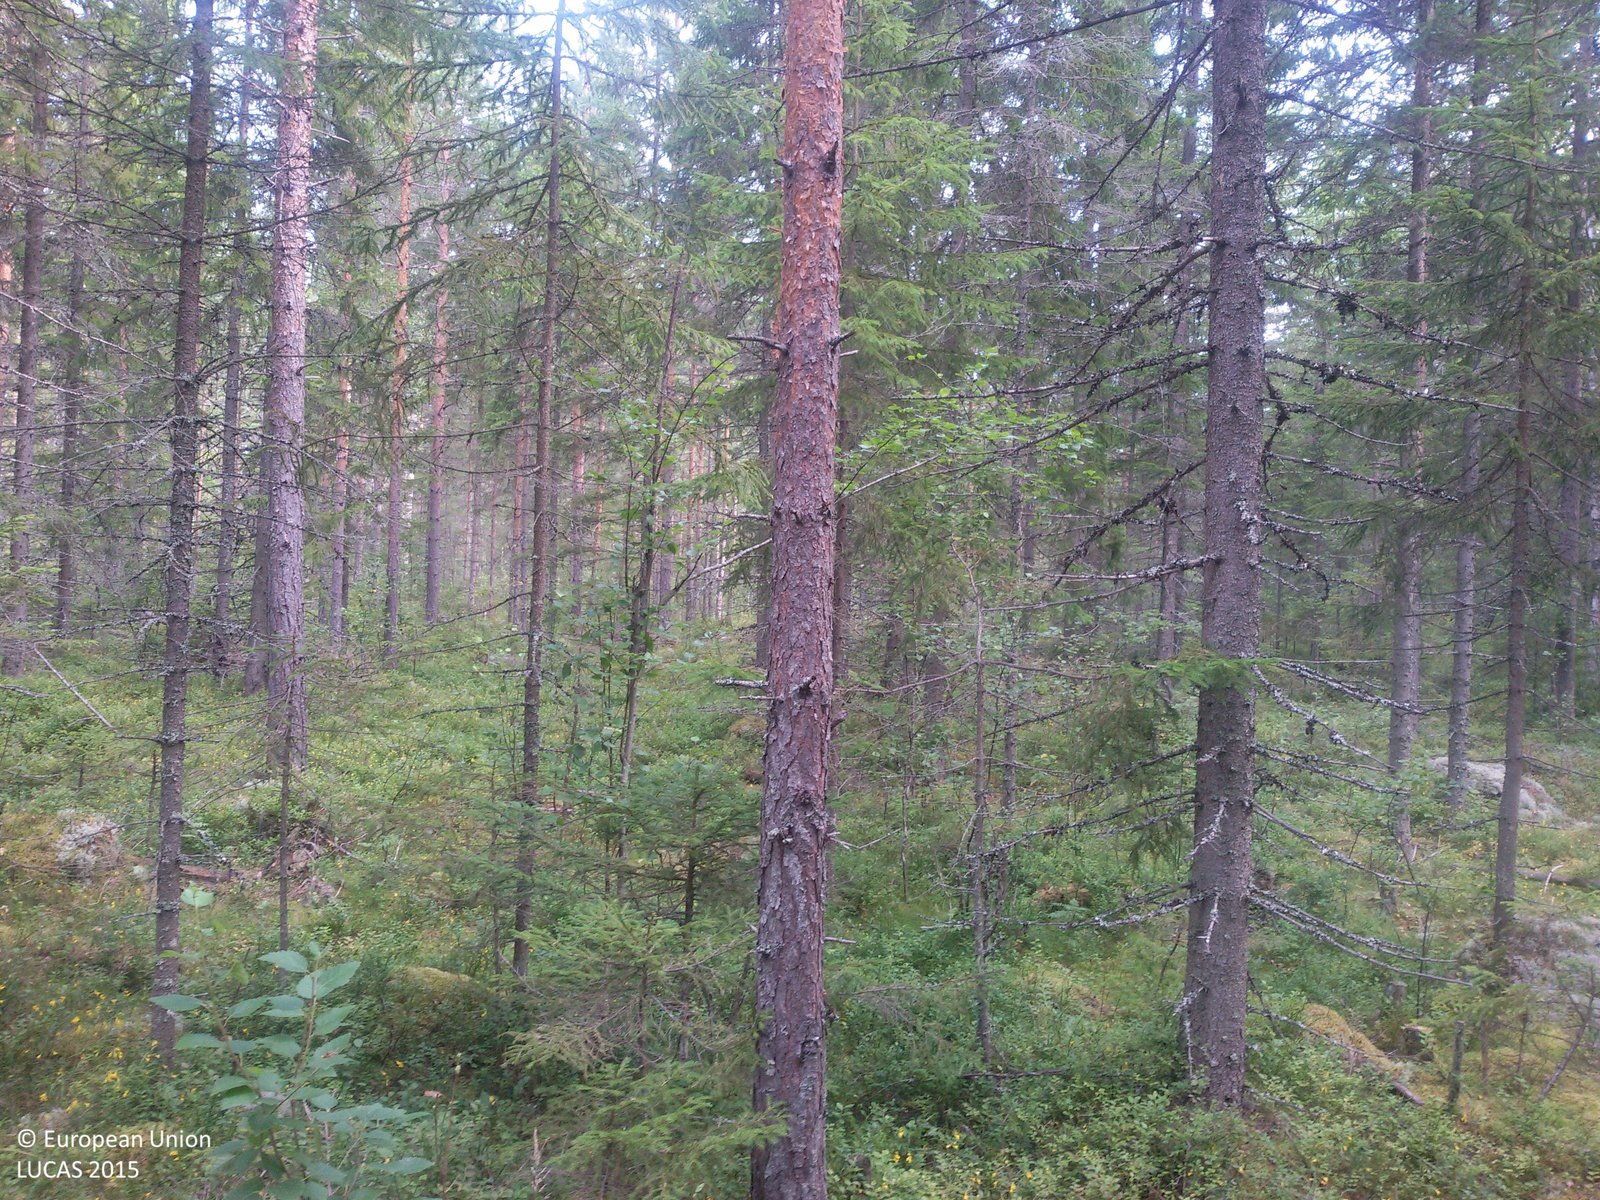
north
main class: Woodland
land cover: Spruce dominated coniferous woodland
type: boreal forest
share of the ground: > 75 %
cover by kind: coniferous forest trees 75 %, shrubs 15 %, herbaceous plants 5 %, lichens and mosses 5 %
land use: Forestry
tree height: > 5 m
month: August
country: SE
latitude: 60.6299
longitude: 16.4403
